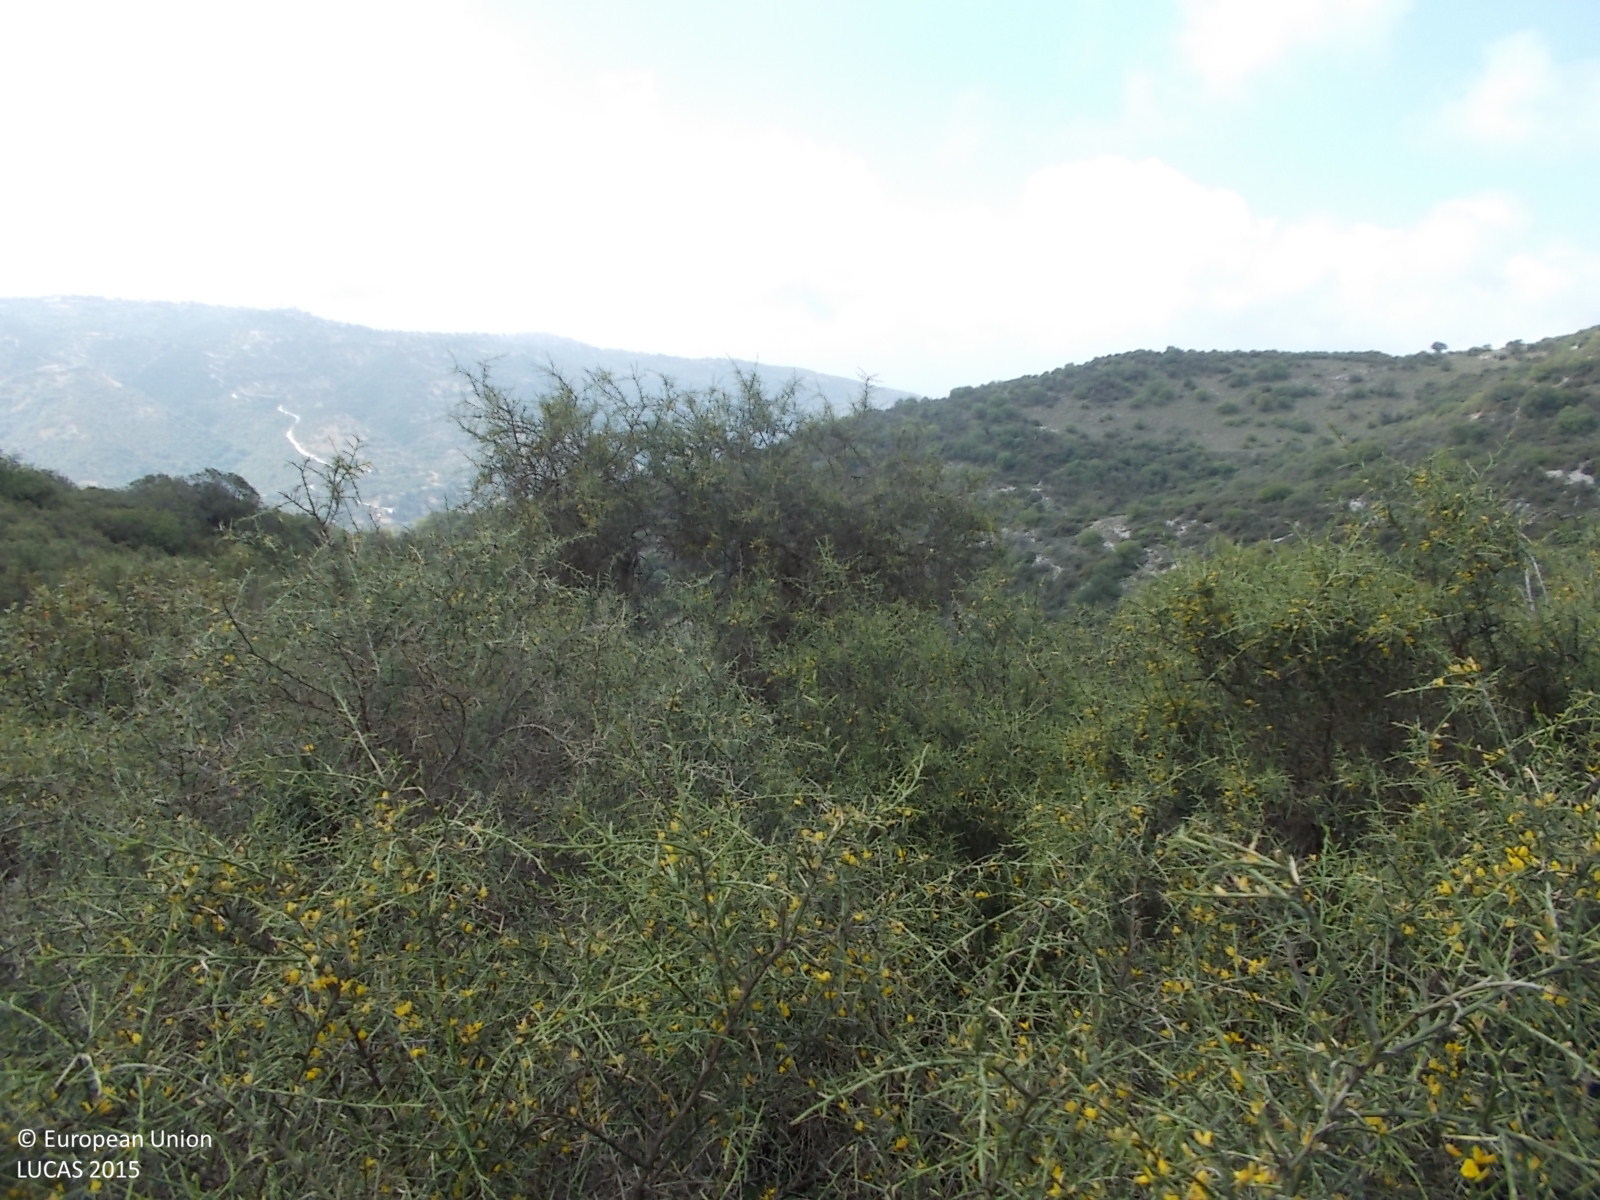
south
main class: Shrubland
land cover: Shrubland with sparse tree cover
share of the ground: > 75 %
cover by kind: shrubs 90 %, broadleaved forest trees 5 %, unconsolidated bare surface 5 %
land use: Semi-natural and natural areas not in use
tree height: < 5 m
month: May
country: CY
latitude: 34.8803
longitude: 32.4351
